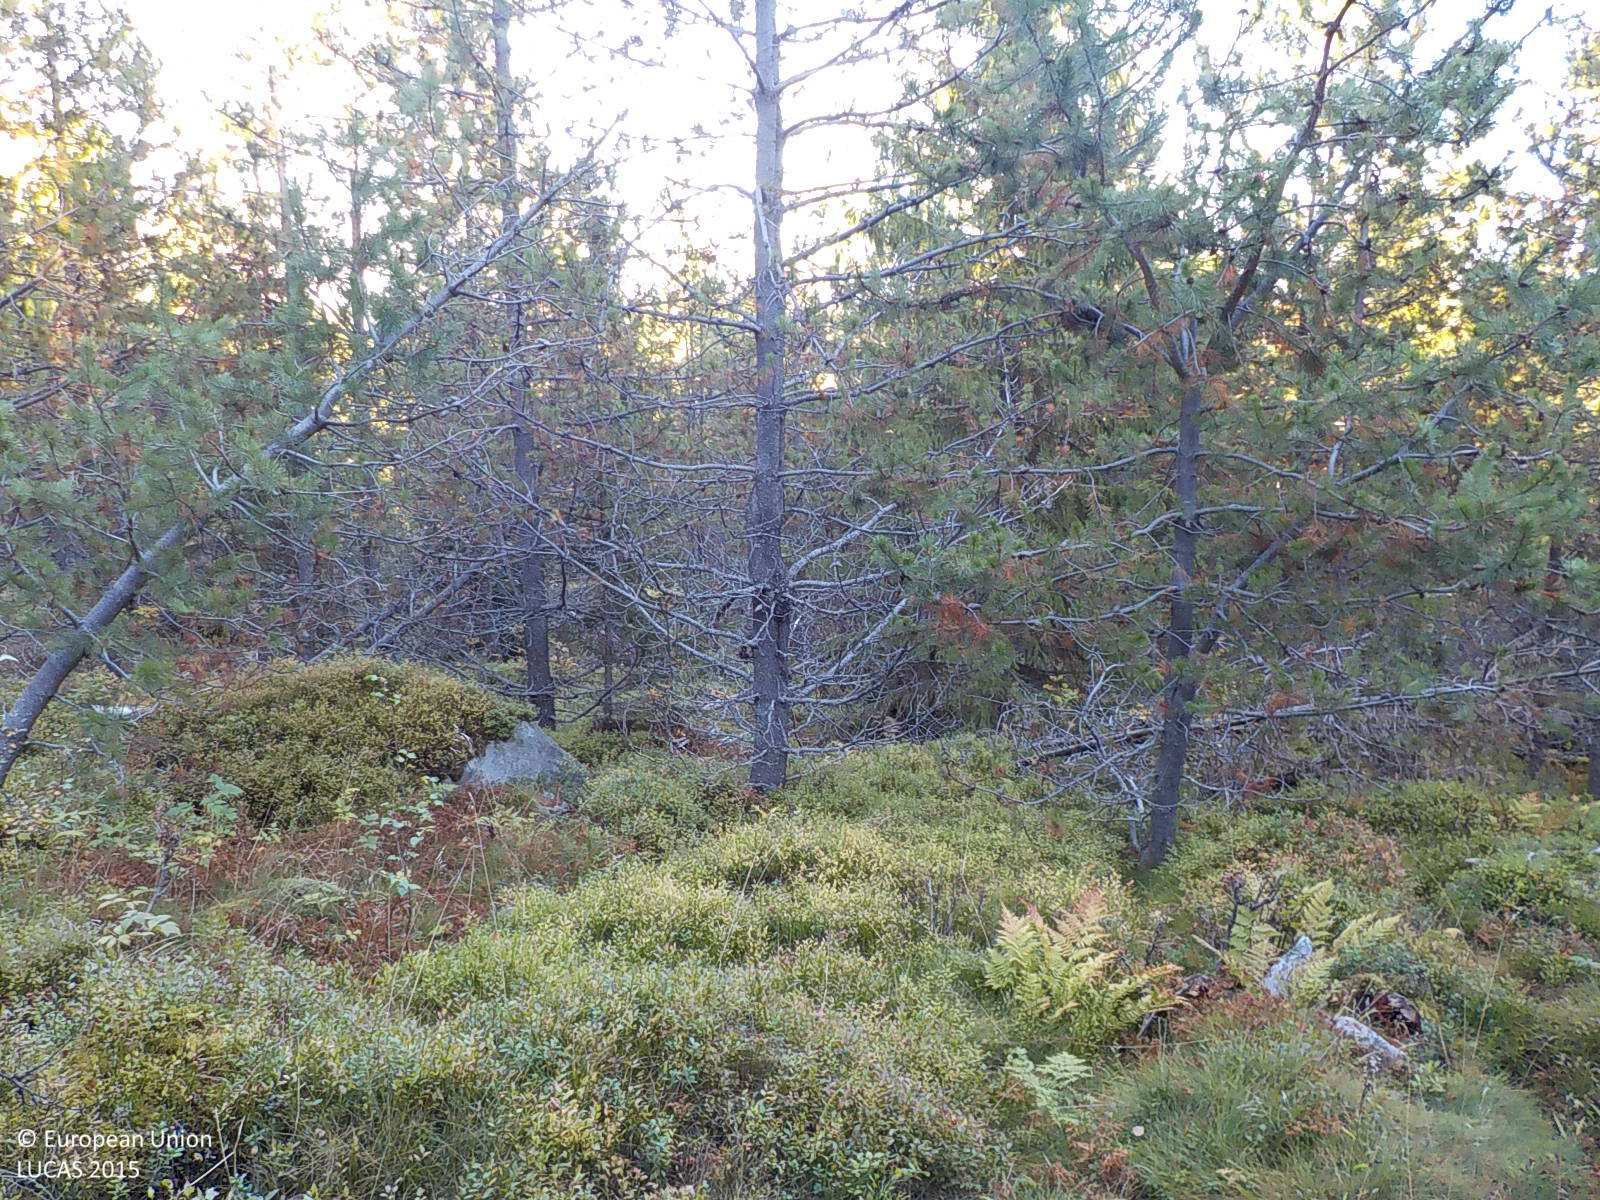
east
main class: Woodland
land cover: Pine dominated coniferous woodland
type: exotic forest
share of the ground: > 75 %
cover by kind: coniferous forest trees 75 %, shrubs 10 %, herbaceous plants 10 %, lichens and mosses 5 %
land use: Forestry
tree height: > 5 m
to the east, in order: Pine dominated coniferous woodland; Broadleaved woodland; Spruce dominated mixed woodland; Ditches and canals; Paved roads, cycling and walking lanes; Broadleaved woodland; Rivers and streams; Spruce dominated mixed woodland
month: September
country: SE
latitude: 63.4740
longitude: 17.1789
